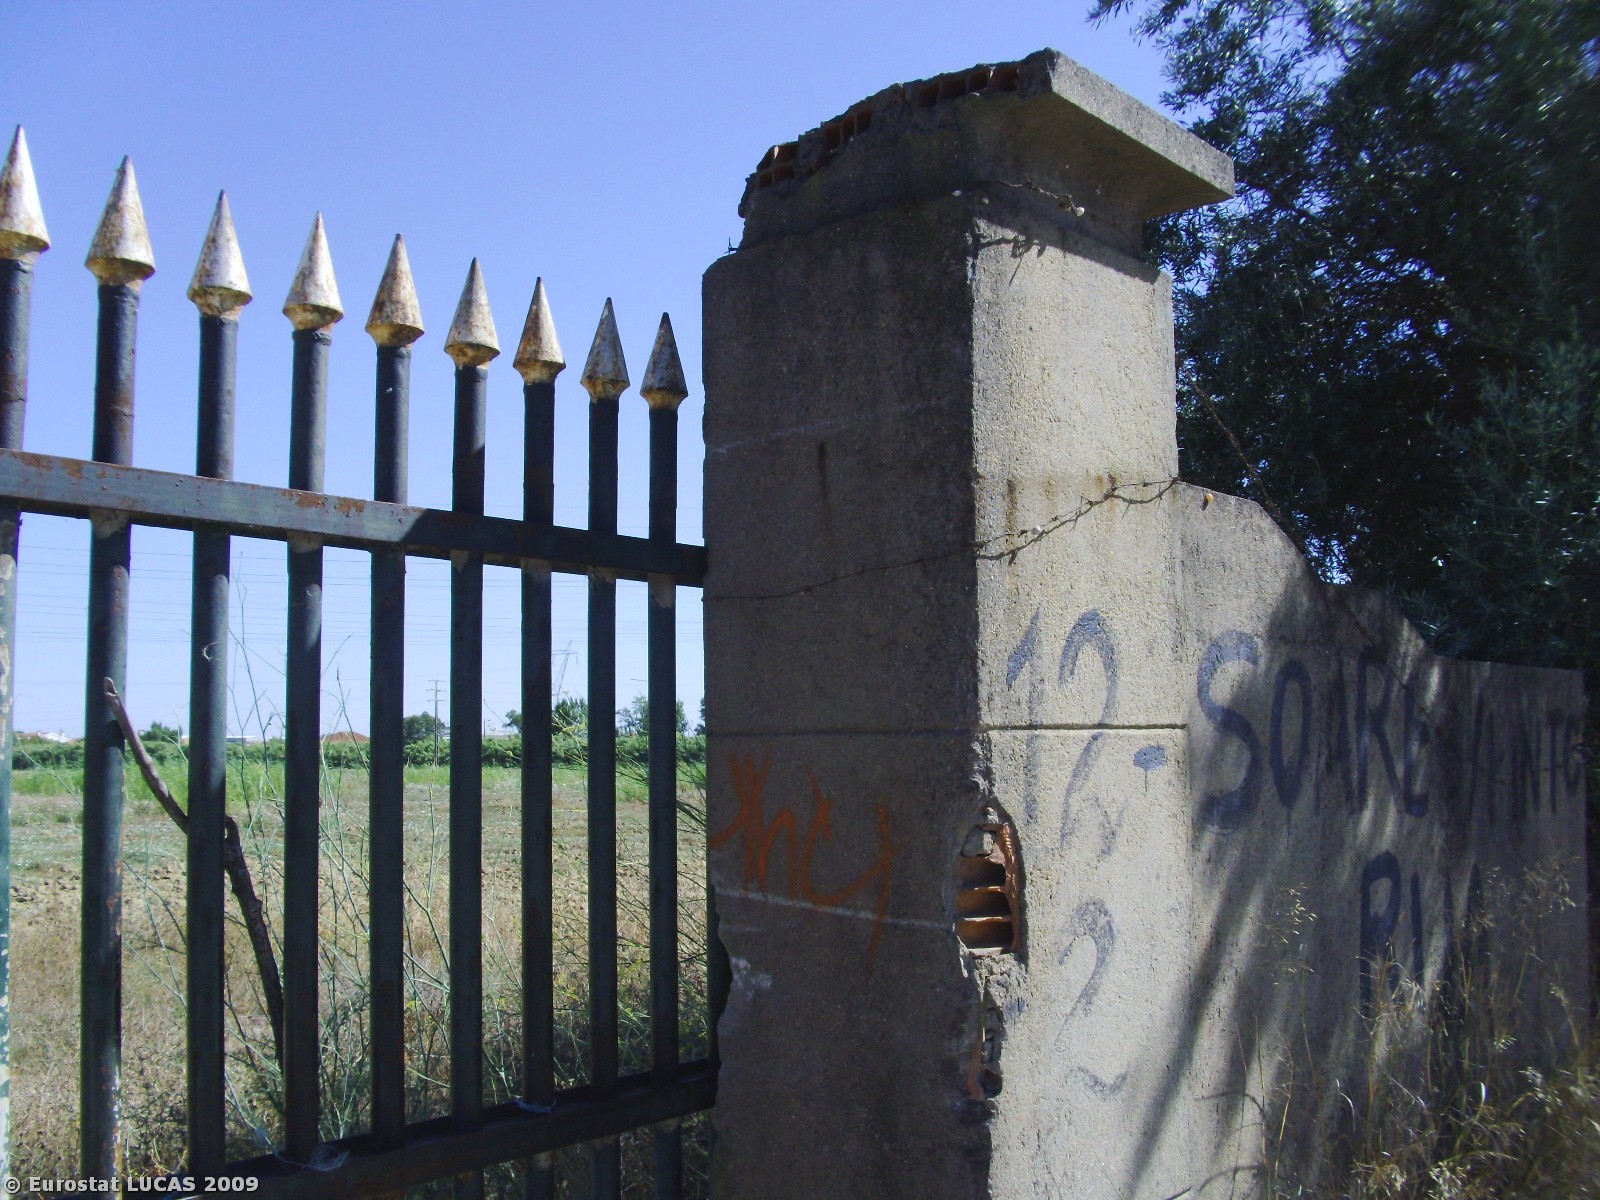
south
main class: Grassland
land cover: Spontaneously vegetated surfaces
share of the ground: > 75 %
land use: Fallow land
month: July
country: PT
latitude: 39.0111
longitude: -8.9576
